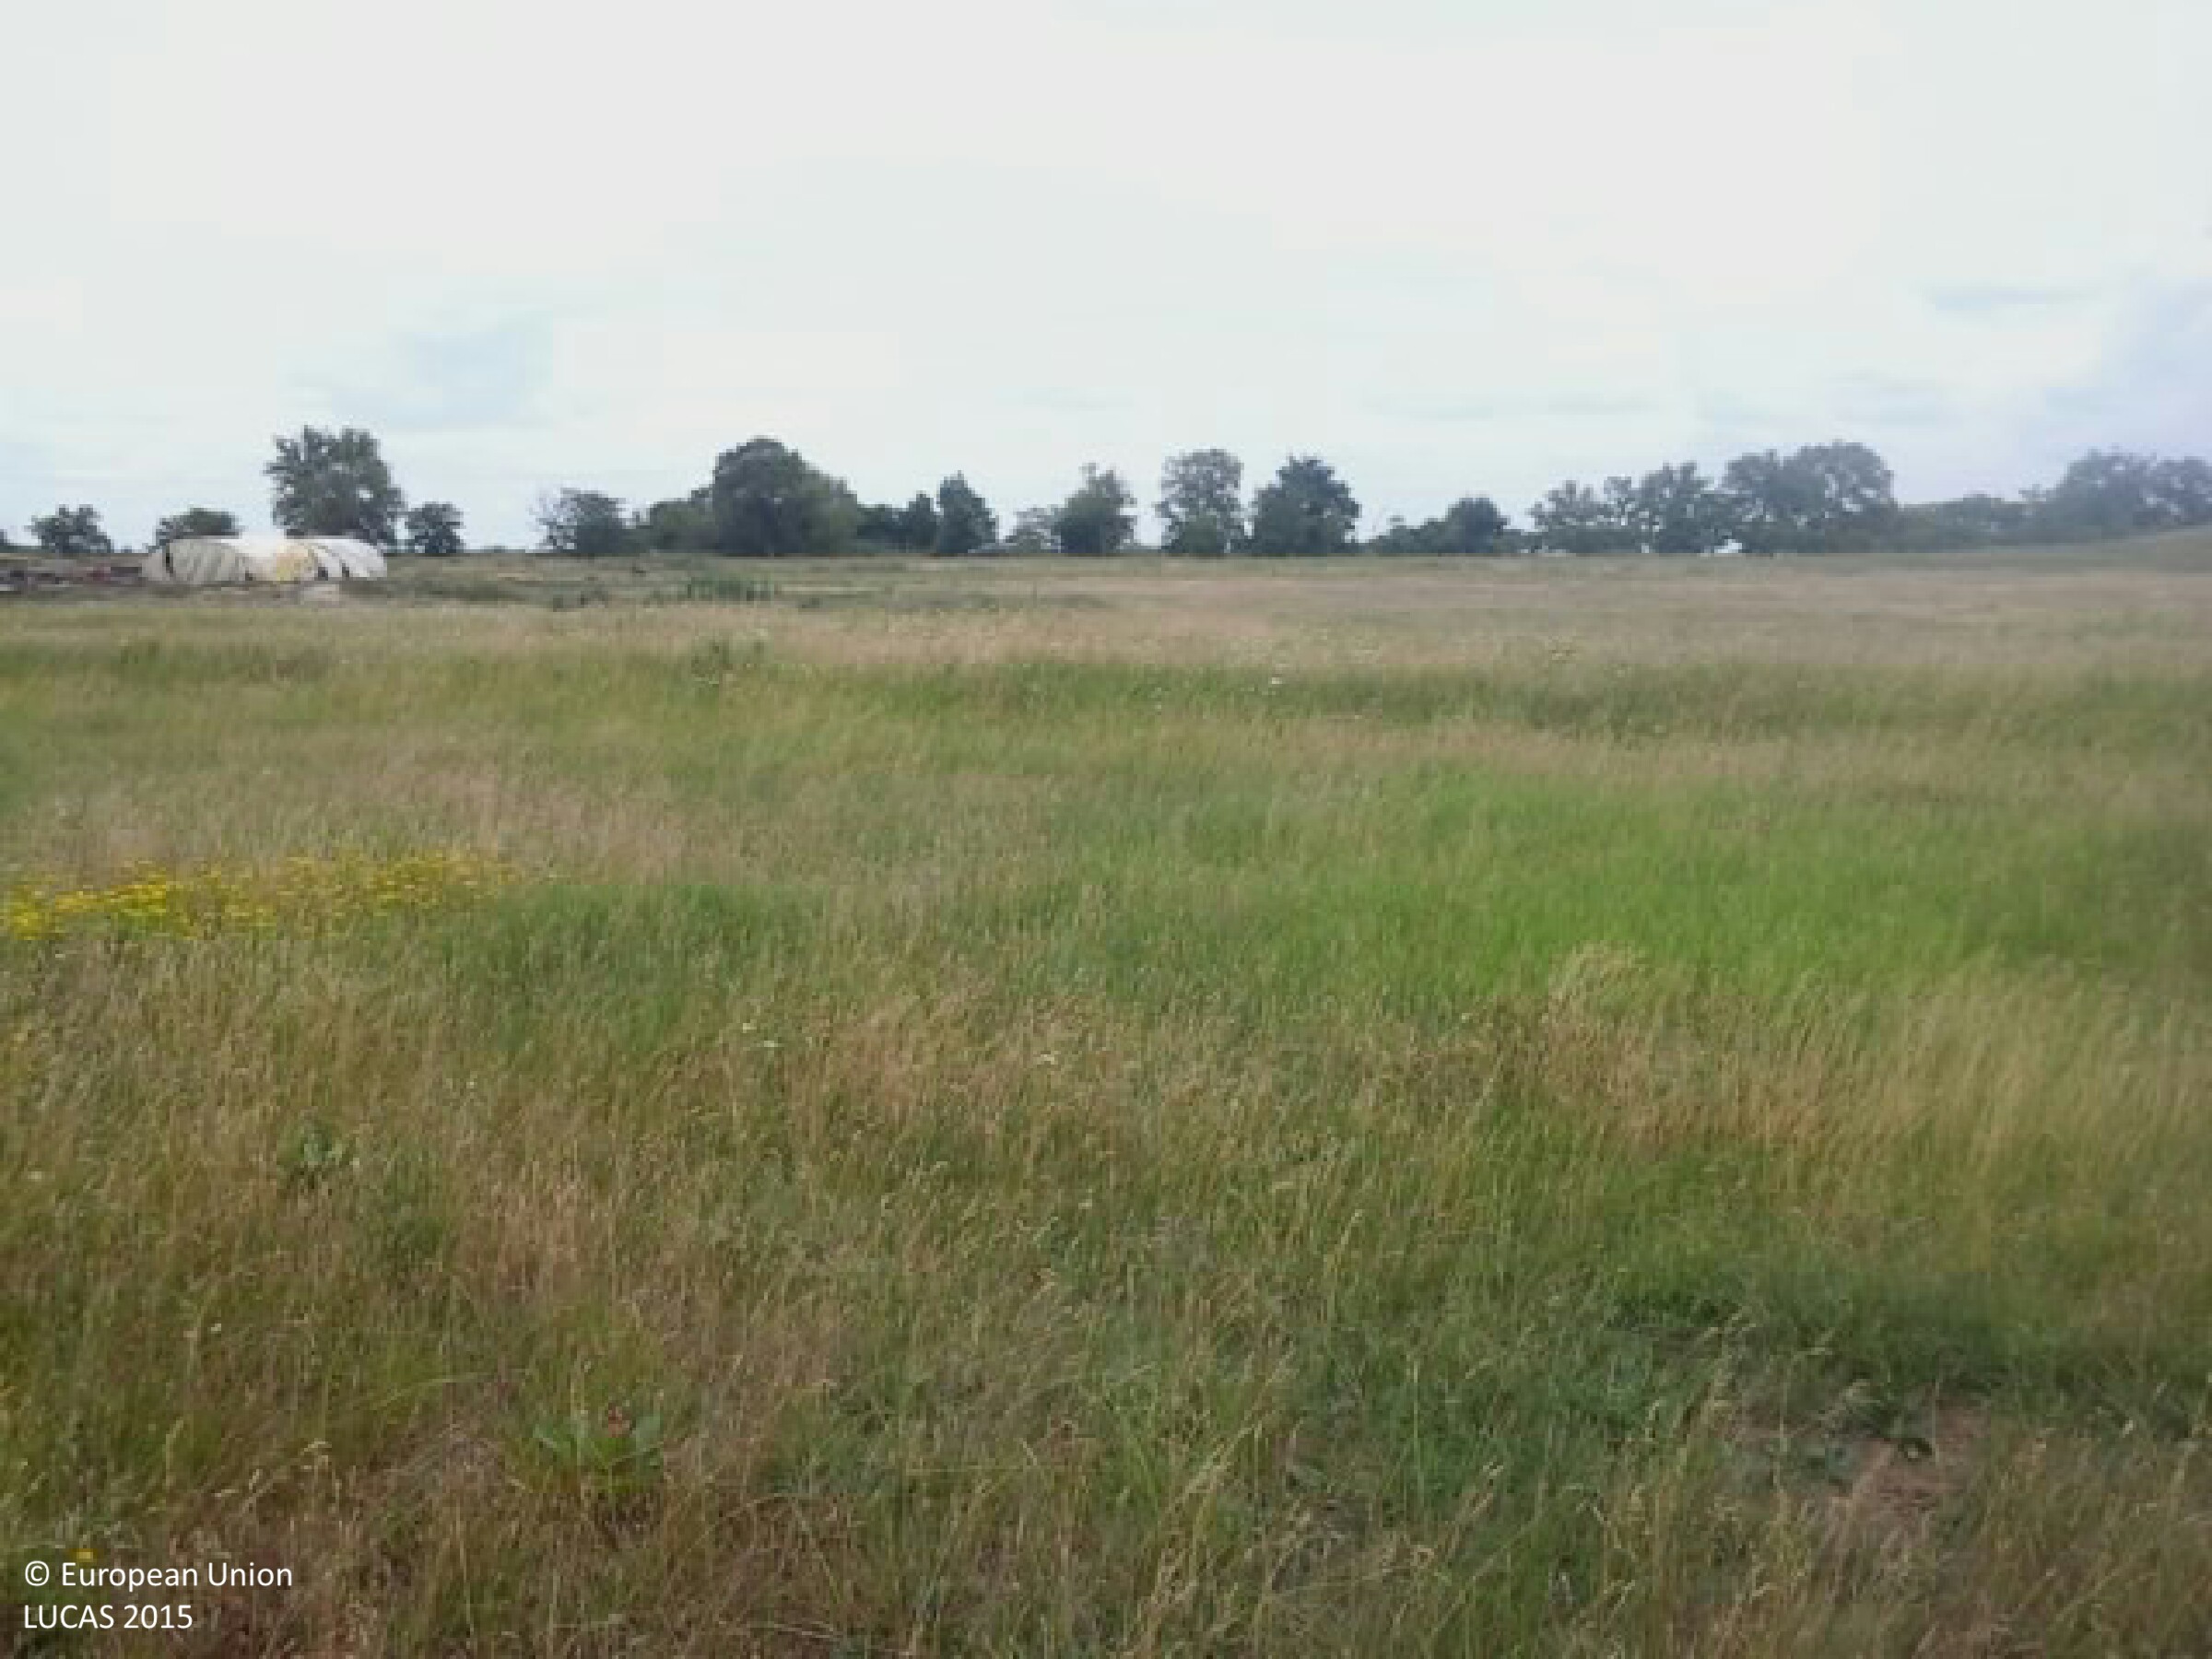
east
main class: Grassland
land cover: Grassland without tree/shrub cover
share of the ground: > 75 %
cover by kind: herbaceous plants 100 %
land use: Agriculture (excluding fallow land and kitchen gardens)
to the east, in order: Grassland without tree/shrub cover; Ditches and canals; Grassland without tree/shrub cover; Spontaneously vegetated surfaces; Tracks; Spontaneously vegetated surfaces; Grass margins; Paved roads, cycling and walking lanes; Grass margins; Ditches and canals; Grass margins
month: June
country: HU
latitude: 46.5410
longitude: 20.3135
